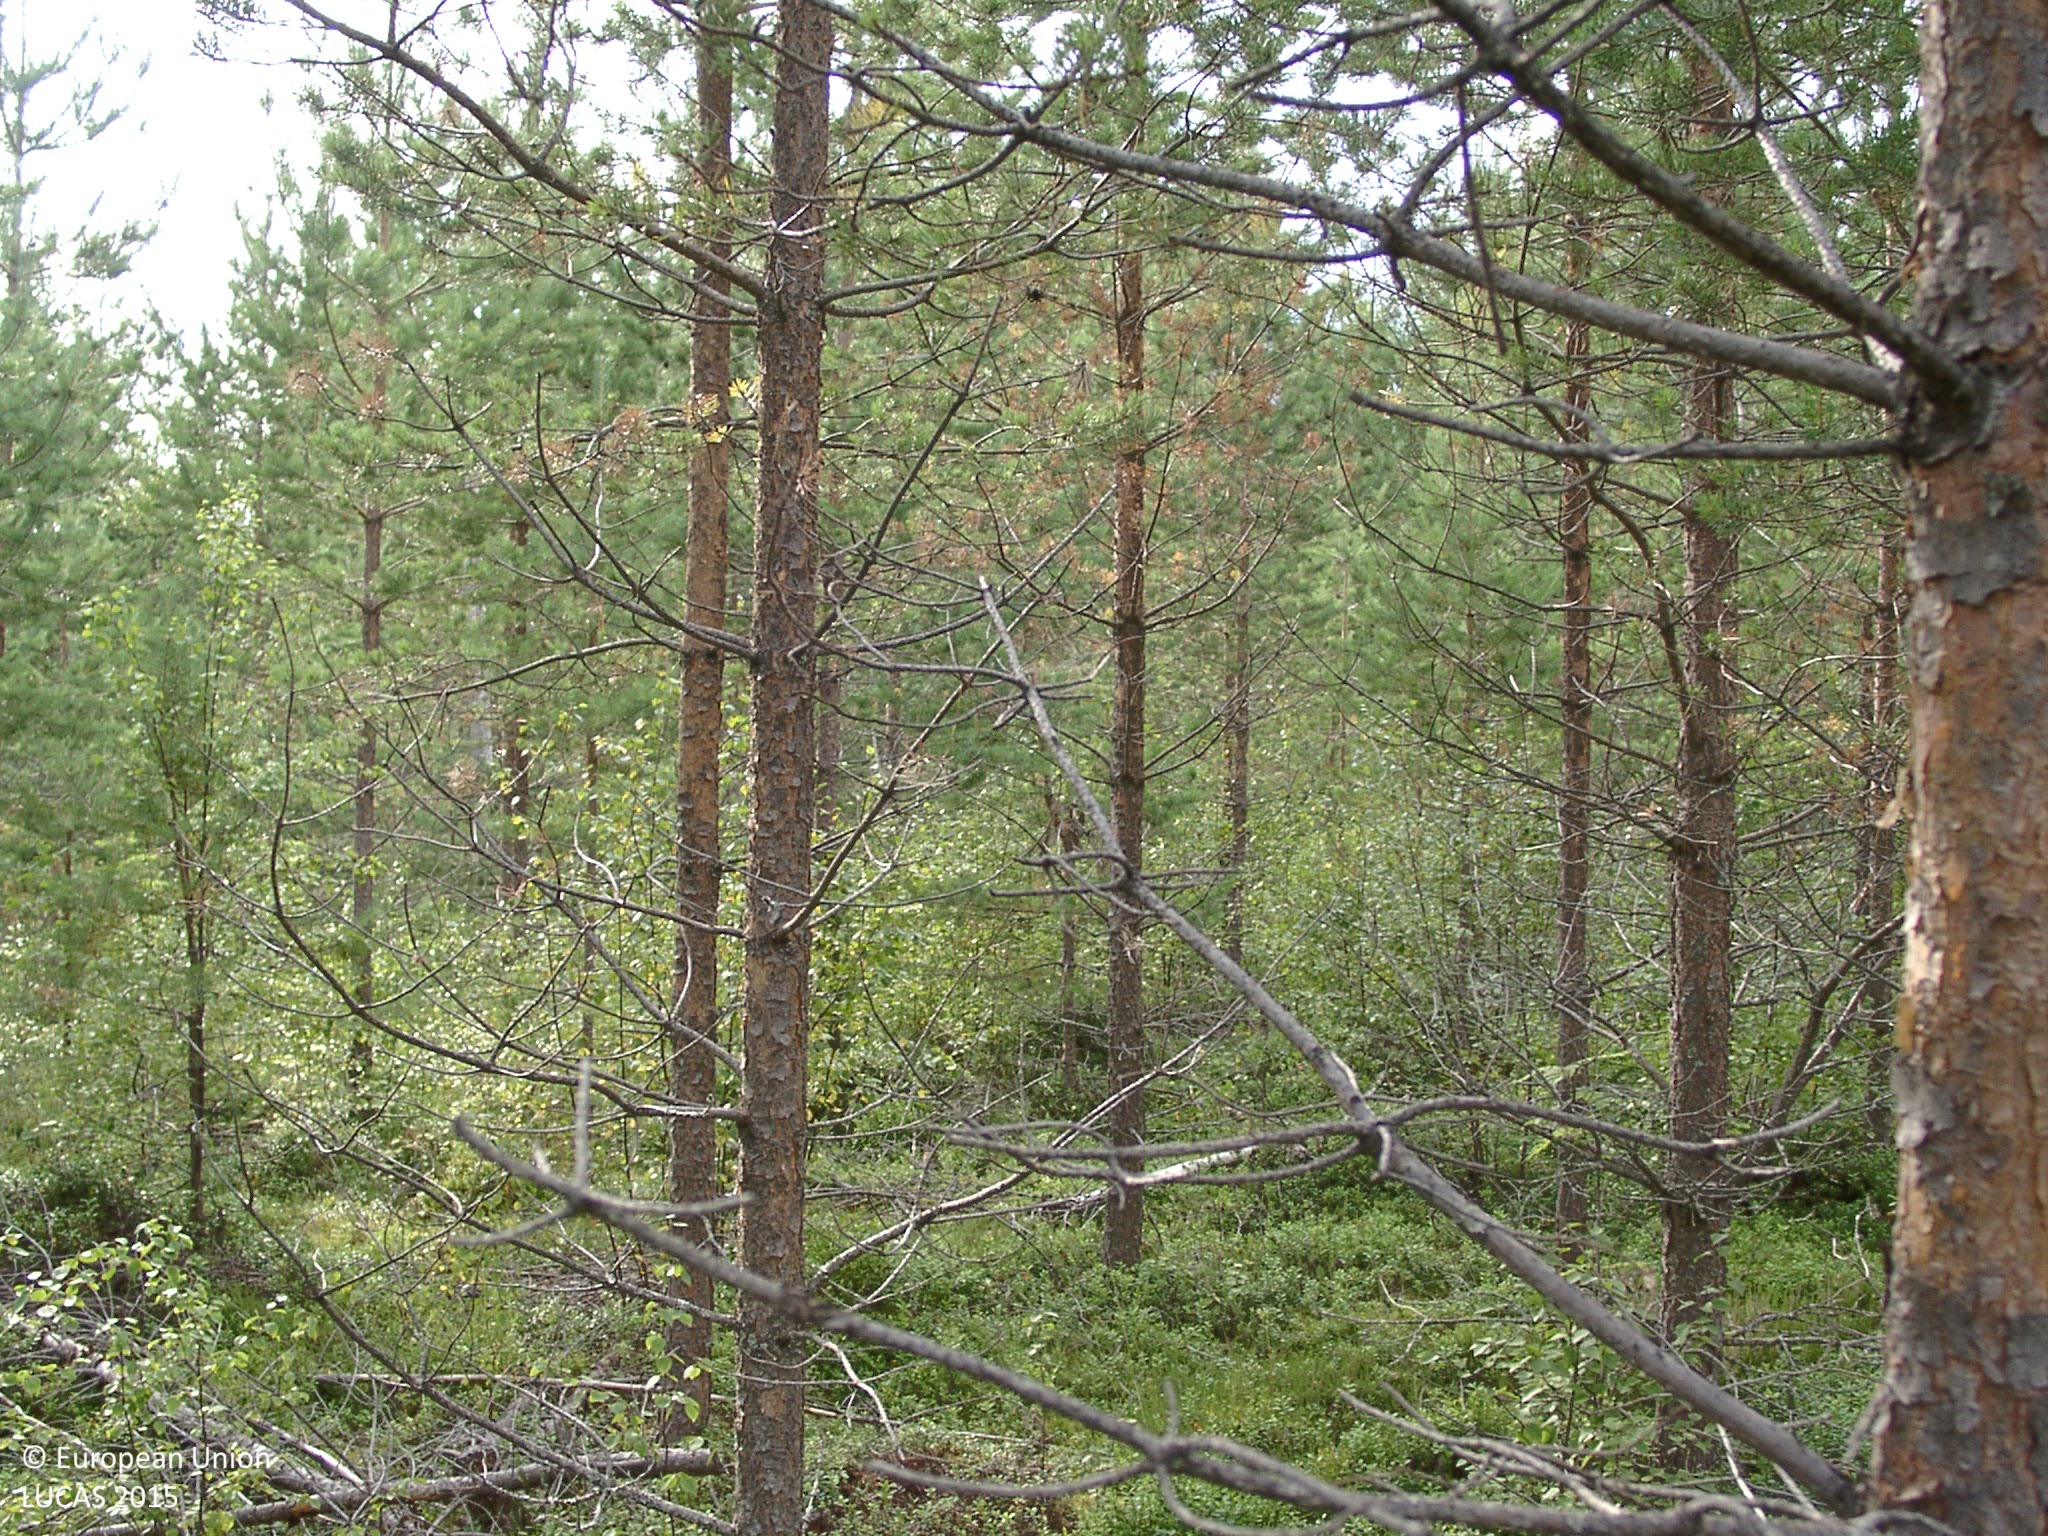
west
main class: Woodland
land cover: Pine dominated coniferous woodland
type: boreal forest
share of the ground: 50 - 75 %
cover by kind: coniferous forest trees 55 %, shrubs 25 %, broadleaved forest trees 10 %, lichens and mosses 10 %
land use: Forestry
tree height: < 5 m
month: August
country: FI
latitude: 62.5668
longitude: 24.5061
